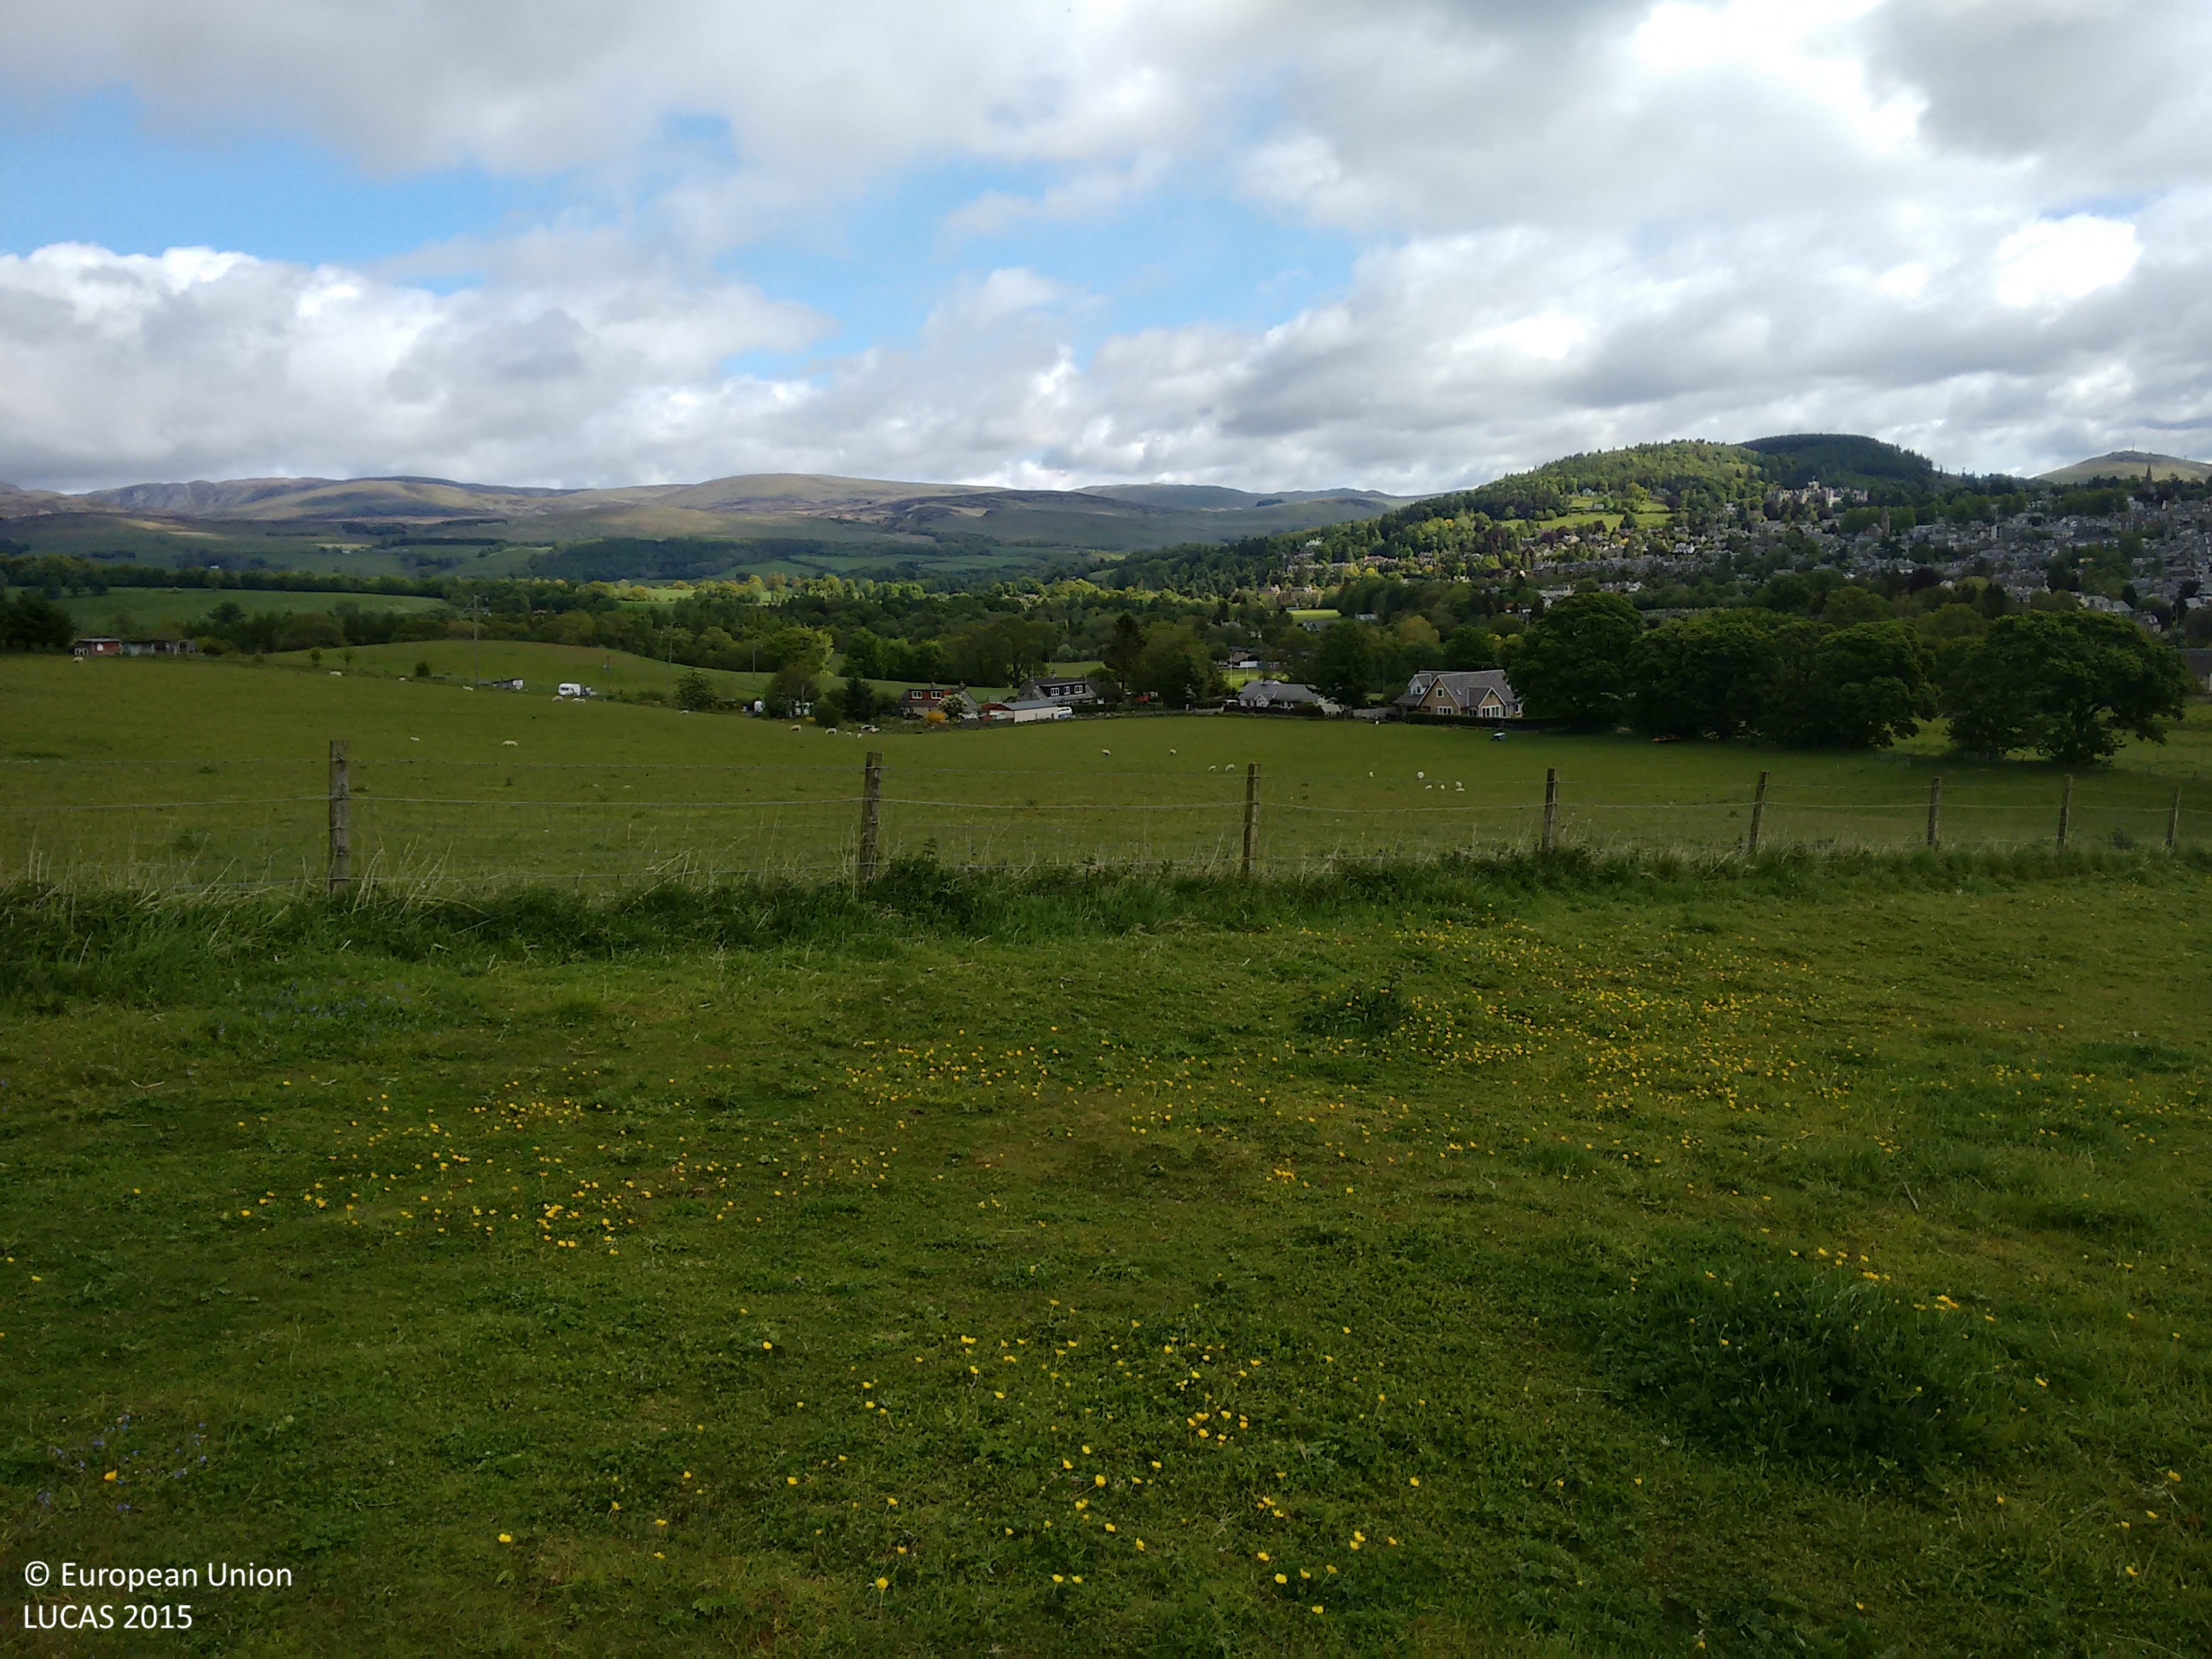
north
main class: Grassland
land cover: Grassland without tree/shrub cover
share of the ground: > 75 %
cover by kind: herbaceous plants 100 %
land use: Agriculture (excluding fallow land and kitchen gardens)
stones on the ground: 10 - 25 %
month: June
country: GB
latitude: 56.3629
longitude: -3.8579
